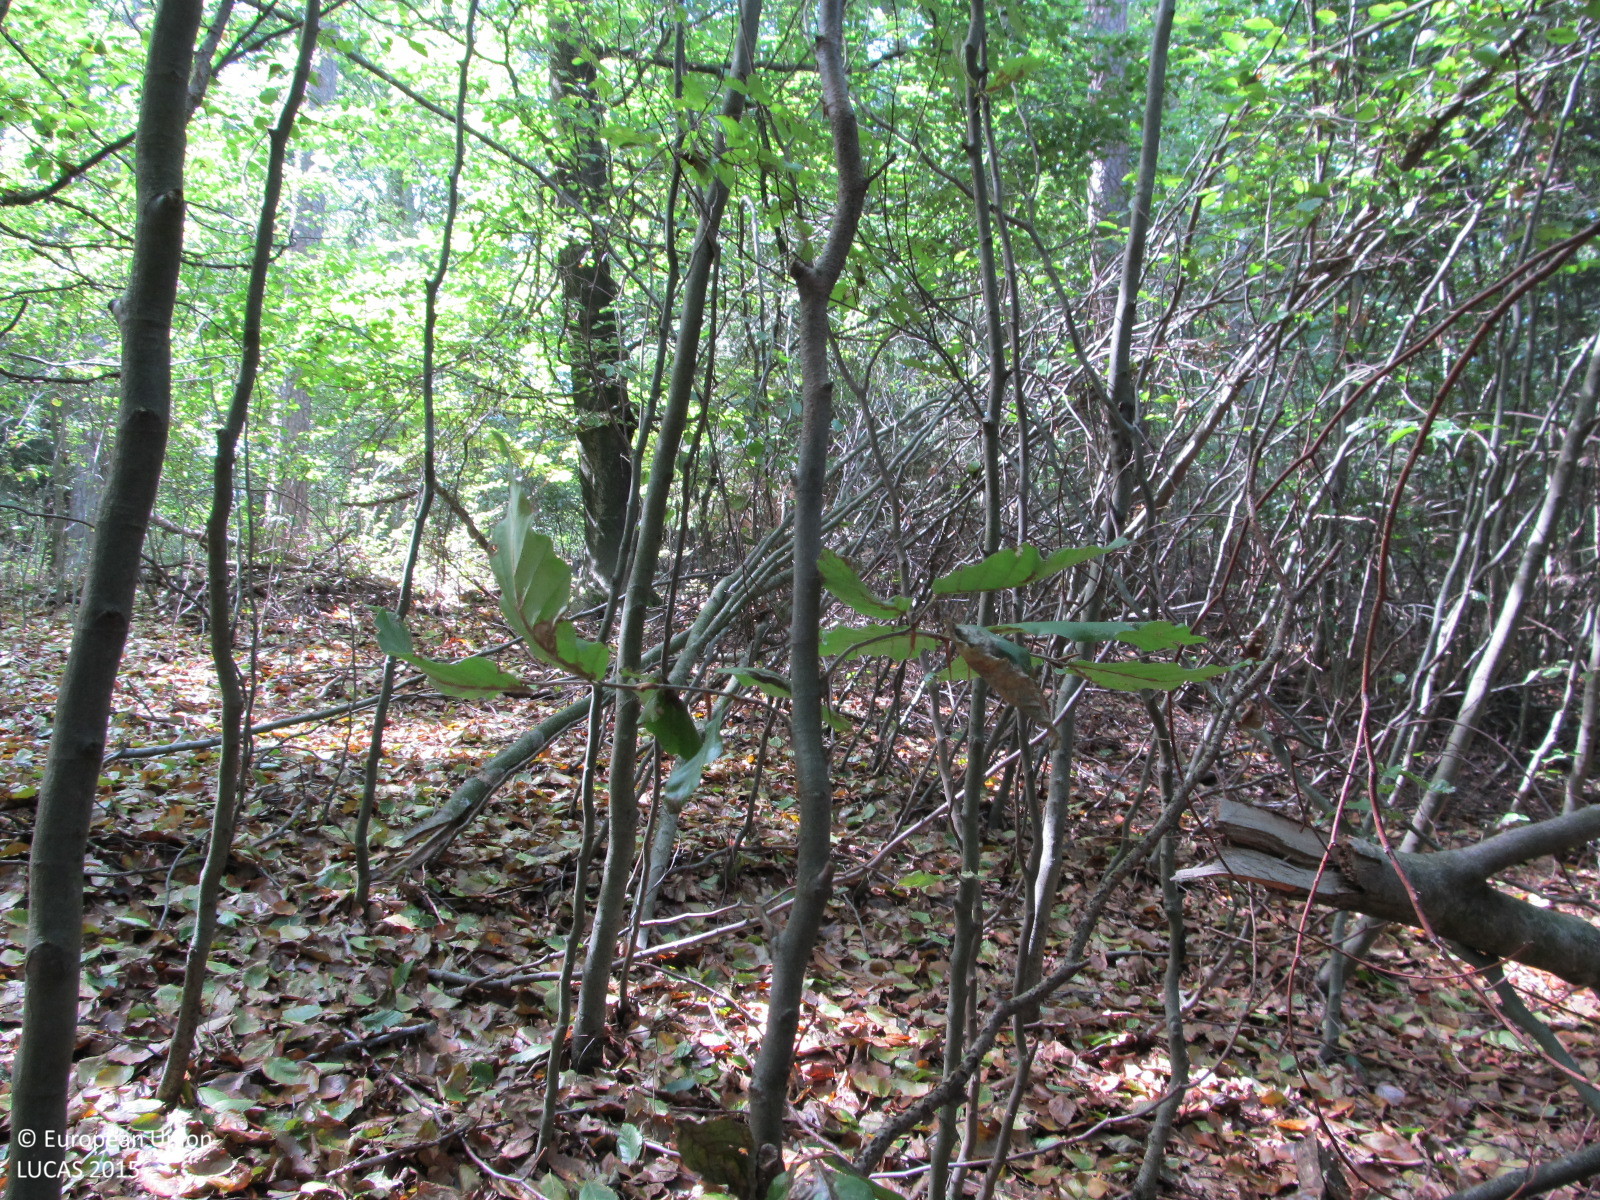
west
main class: Woodland
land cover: Broadleaved woodland
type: beech forest
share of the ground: > 75 %
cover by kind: broadleaved forest trees 80 %, unconsolidated bare surface 20 %
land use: Forestry
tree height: > 5 m
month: August
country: AT
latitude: 48.7695
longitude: 15.5409
